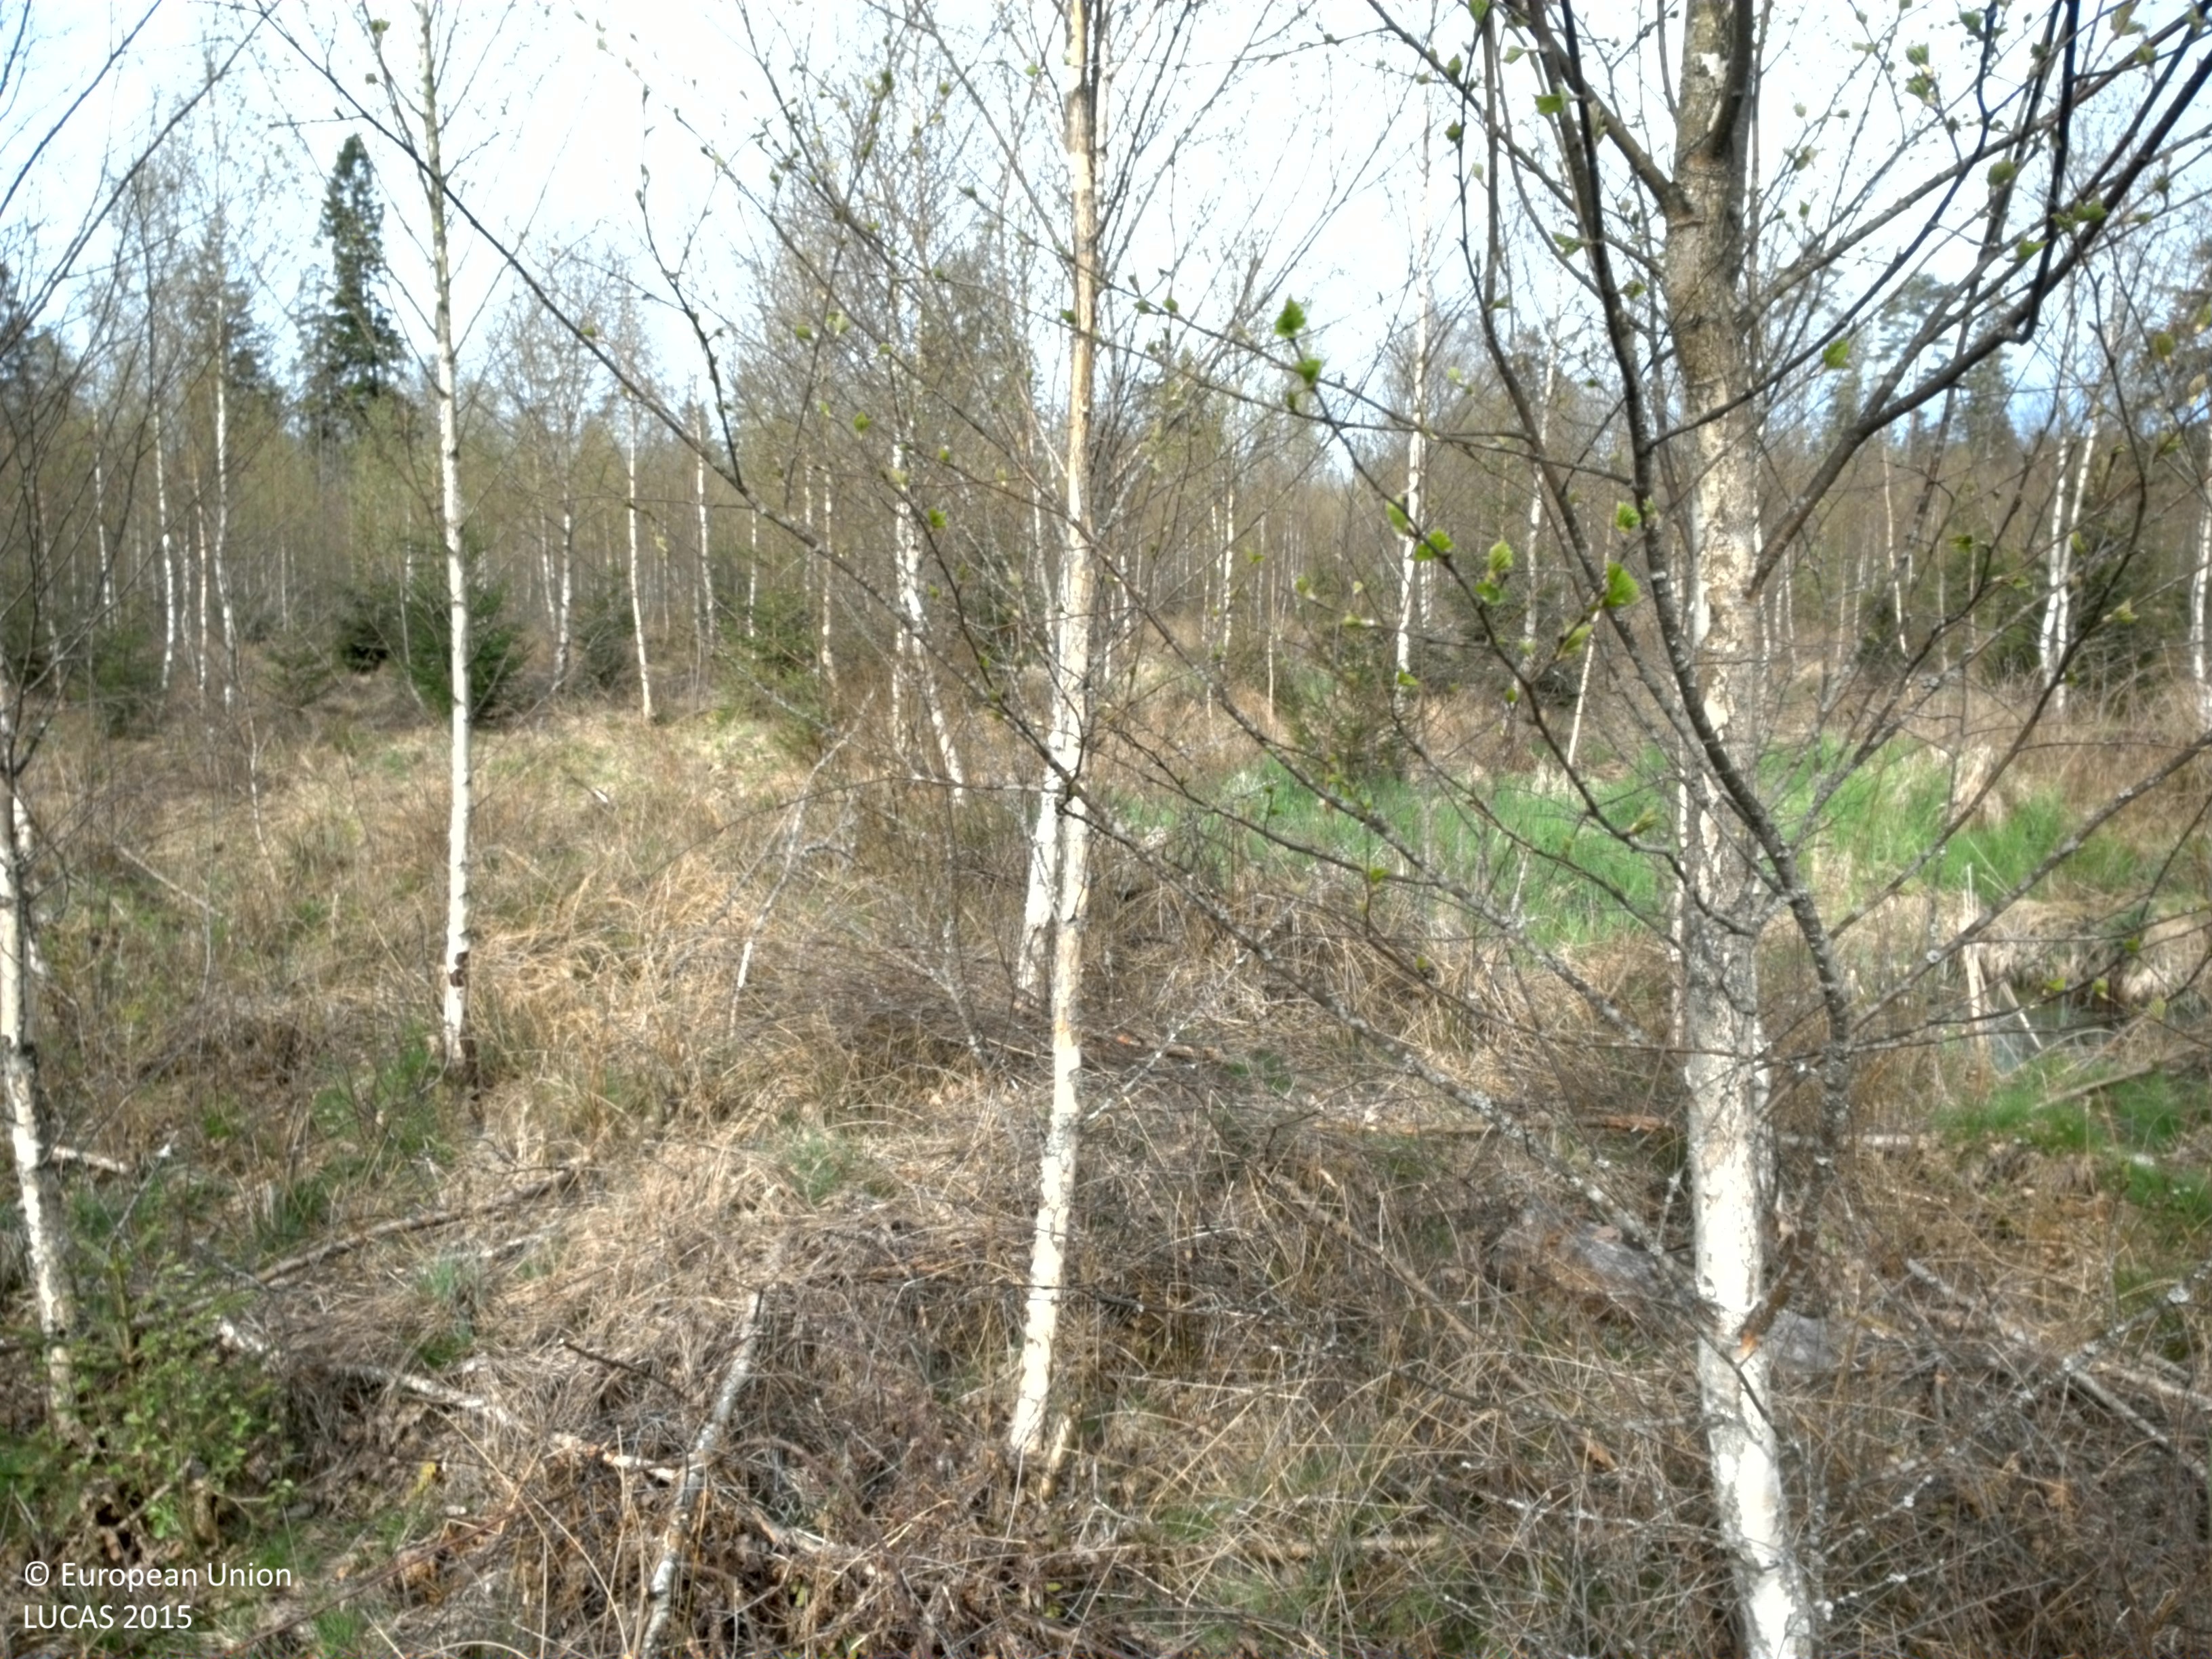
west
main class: Woodland
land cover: Spruce dominated mixed woodland
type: boreal forest
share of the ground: > 75 %
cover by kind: coniferous forest trees 45 %, broadleaved forest trees 45 %
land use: Forestry
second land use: Amenities, museums, leisure
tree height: < 5 m
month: May
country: SE
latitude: 56.7828
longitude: 14.7929
